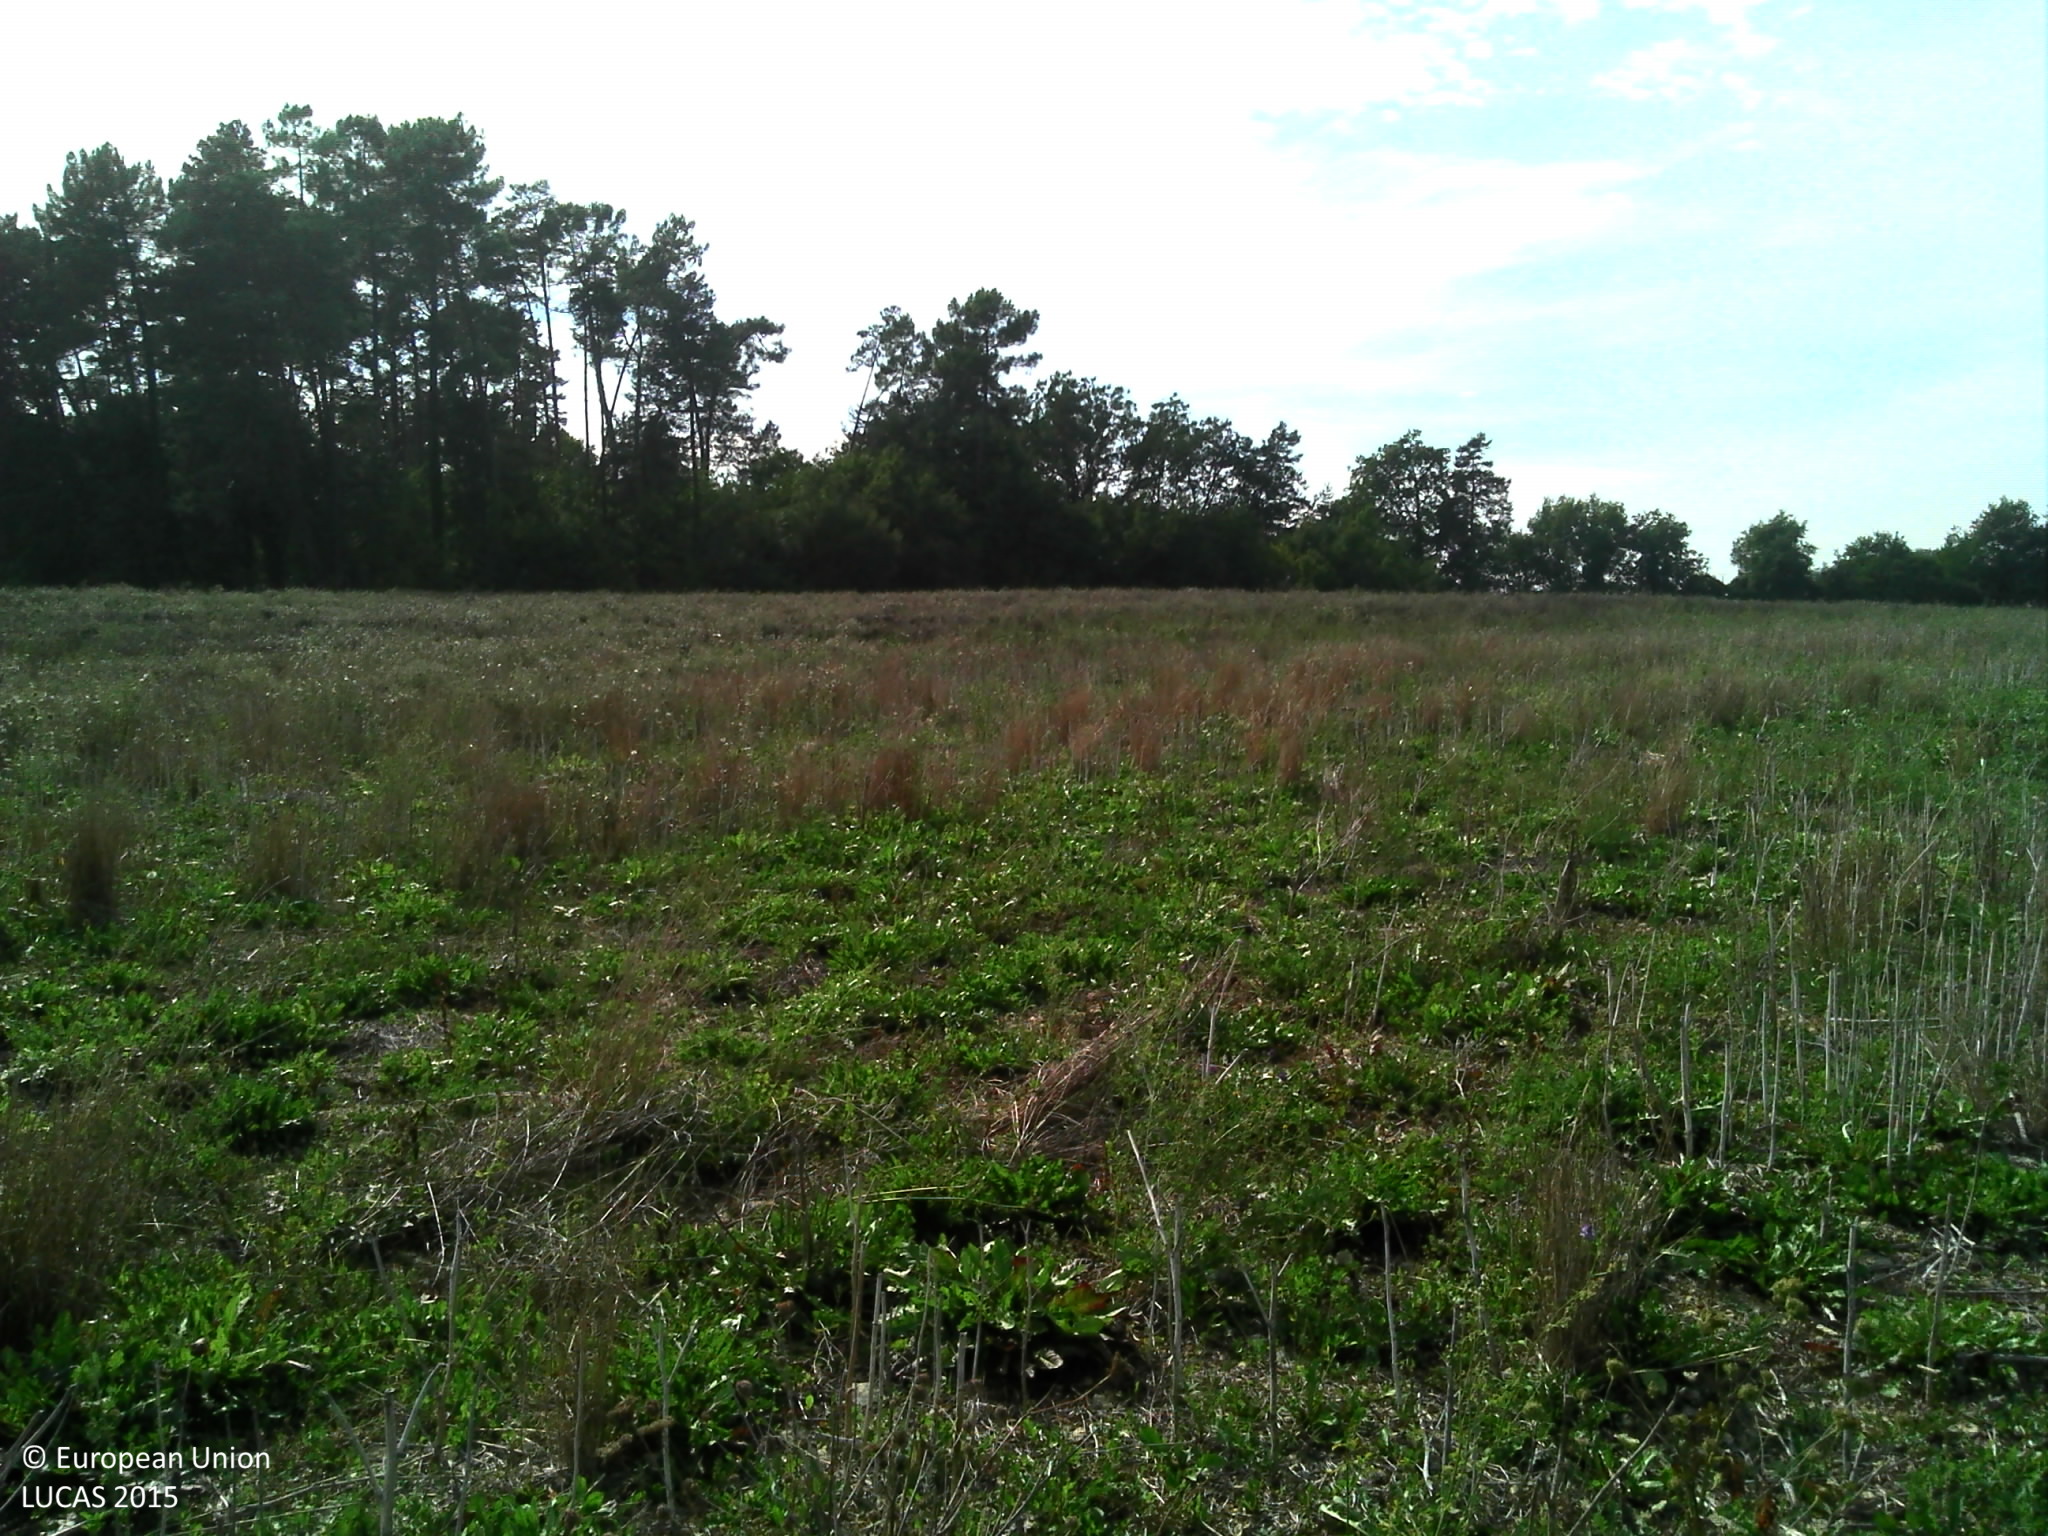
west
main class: Grassland
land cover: Spontaneously vegetated surfaces
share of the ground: 50 - 75 %
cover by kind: herbaceous plants 60 %, consolidated bare surface 40 %
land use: Agriculture (excluding fallow land and kitchen gardens)
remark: Harvested field
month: August
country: FR
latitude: 45.3989
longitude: 0.4701
